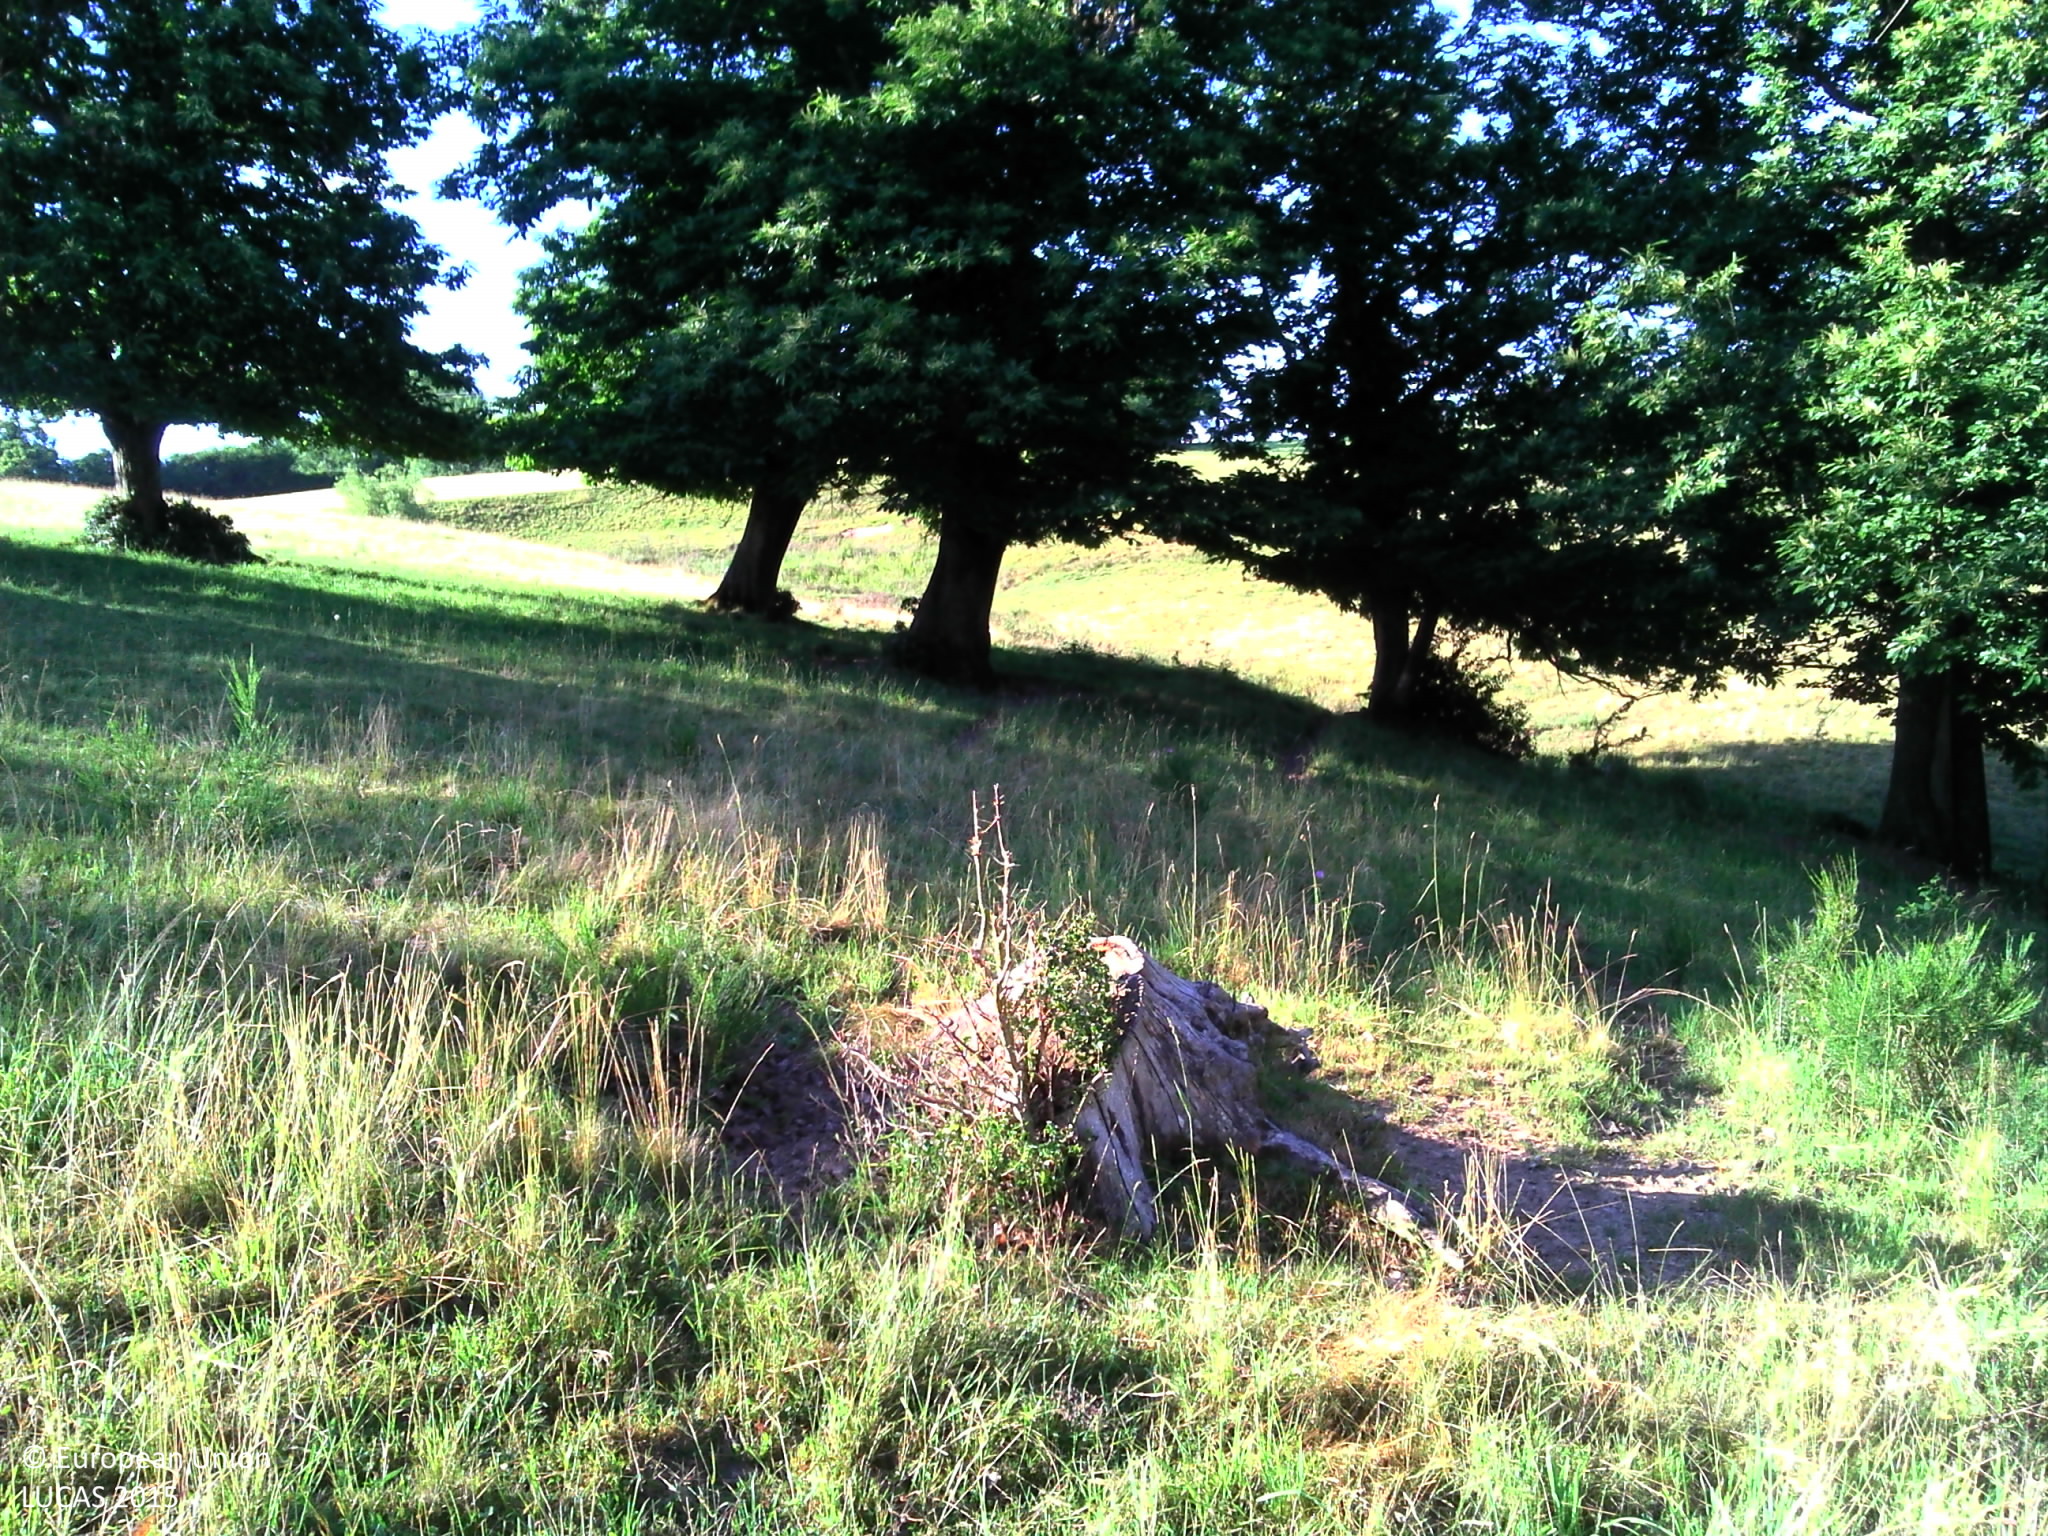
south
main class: Grassland
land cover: Grassland without tree/shrub cover
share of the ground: > 75 %
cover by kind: herbaceous plants 100 %
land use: Agriculture (excluding fallow land and kitchen gardens)
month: June
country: FR
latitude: 44.8678
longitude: 2.3938
